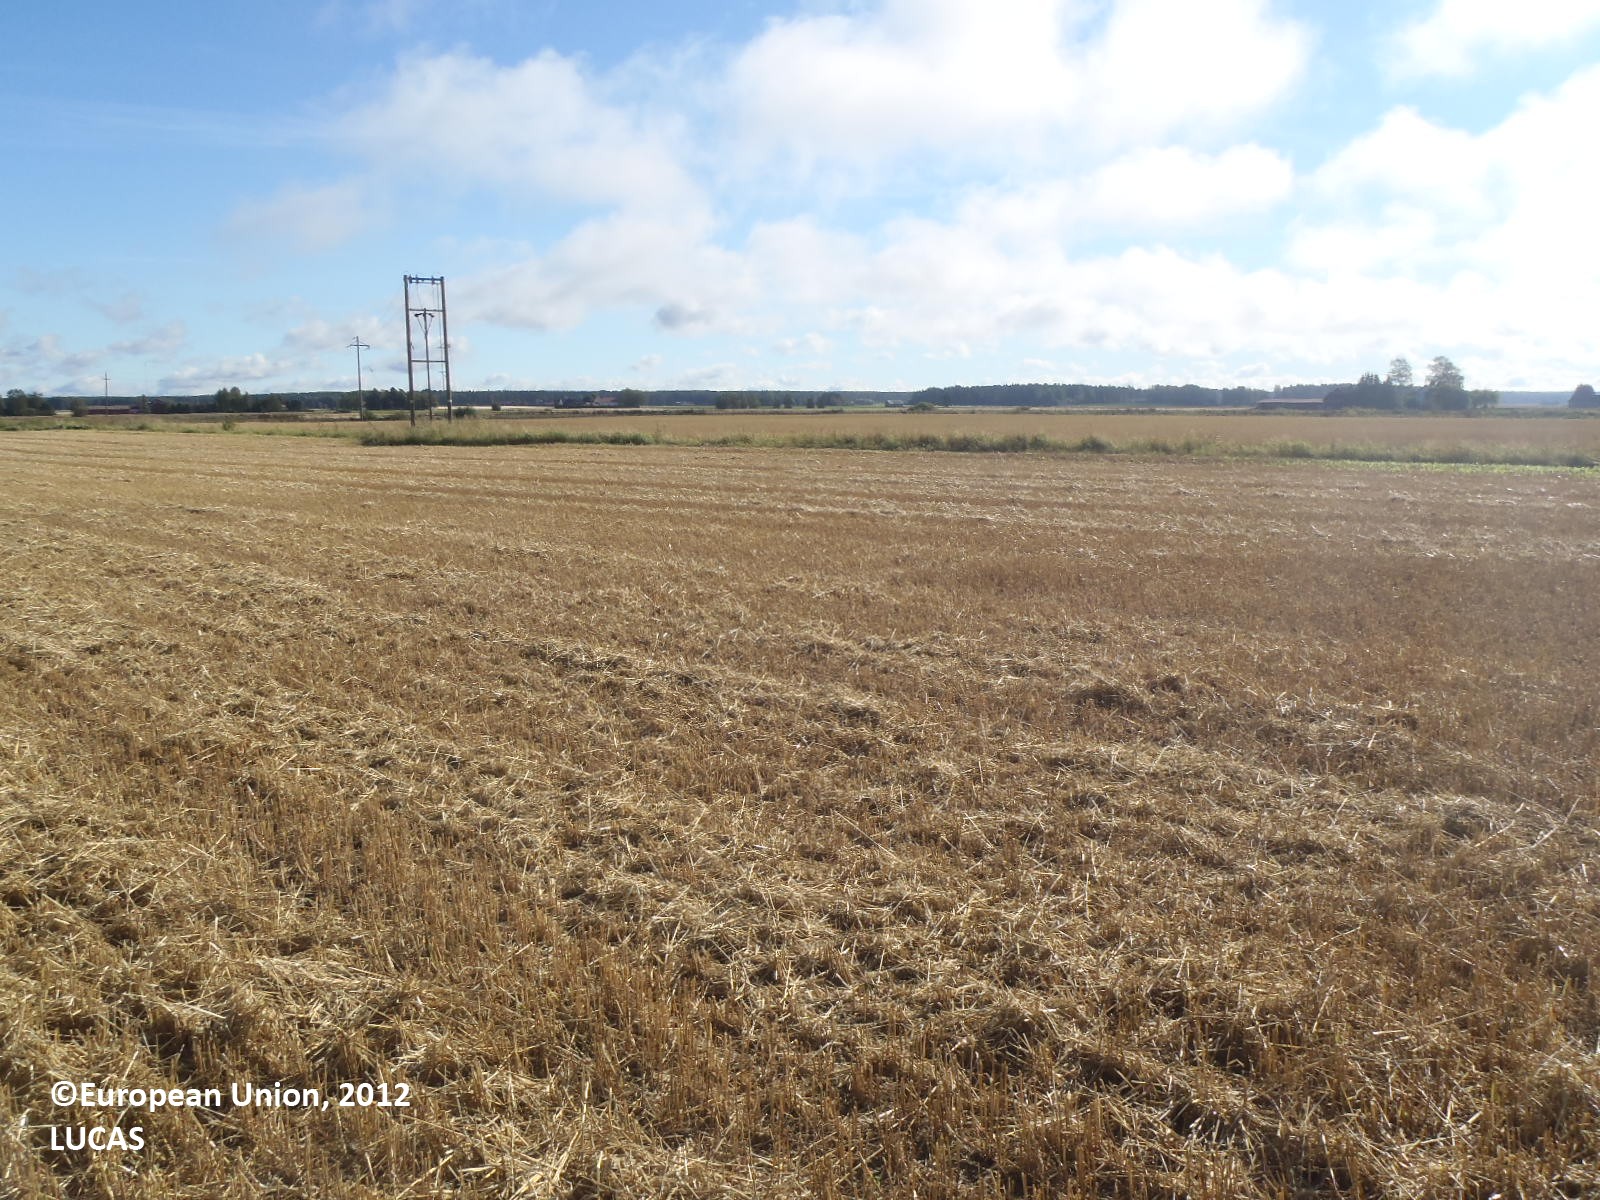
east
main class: Cropland
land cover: Barley
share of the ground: > 75 %
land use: Agriculture (excluding fallow land and kitchen gardens)
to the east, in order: Barley; Grass margins; Ditches and canals; Grass margins; Common wheat; Grass margins; Ditches and canals; Grass margins; Other bare soil; Grass margins; Ditches and canals; Grass margins; Paved roads, cycling and walking lanes
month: September
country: FI
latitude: 61.0600
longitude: 22.3469
